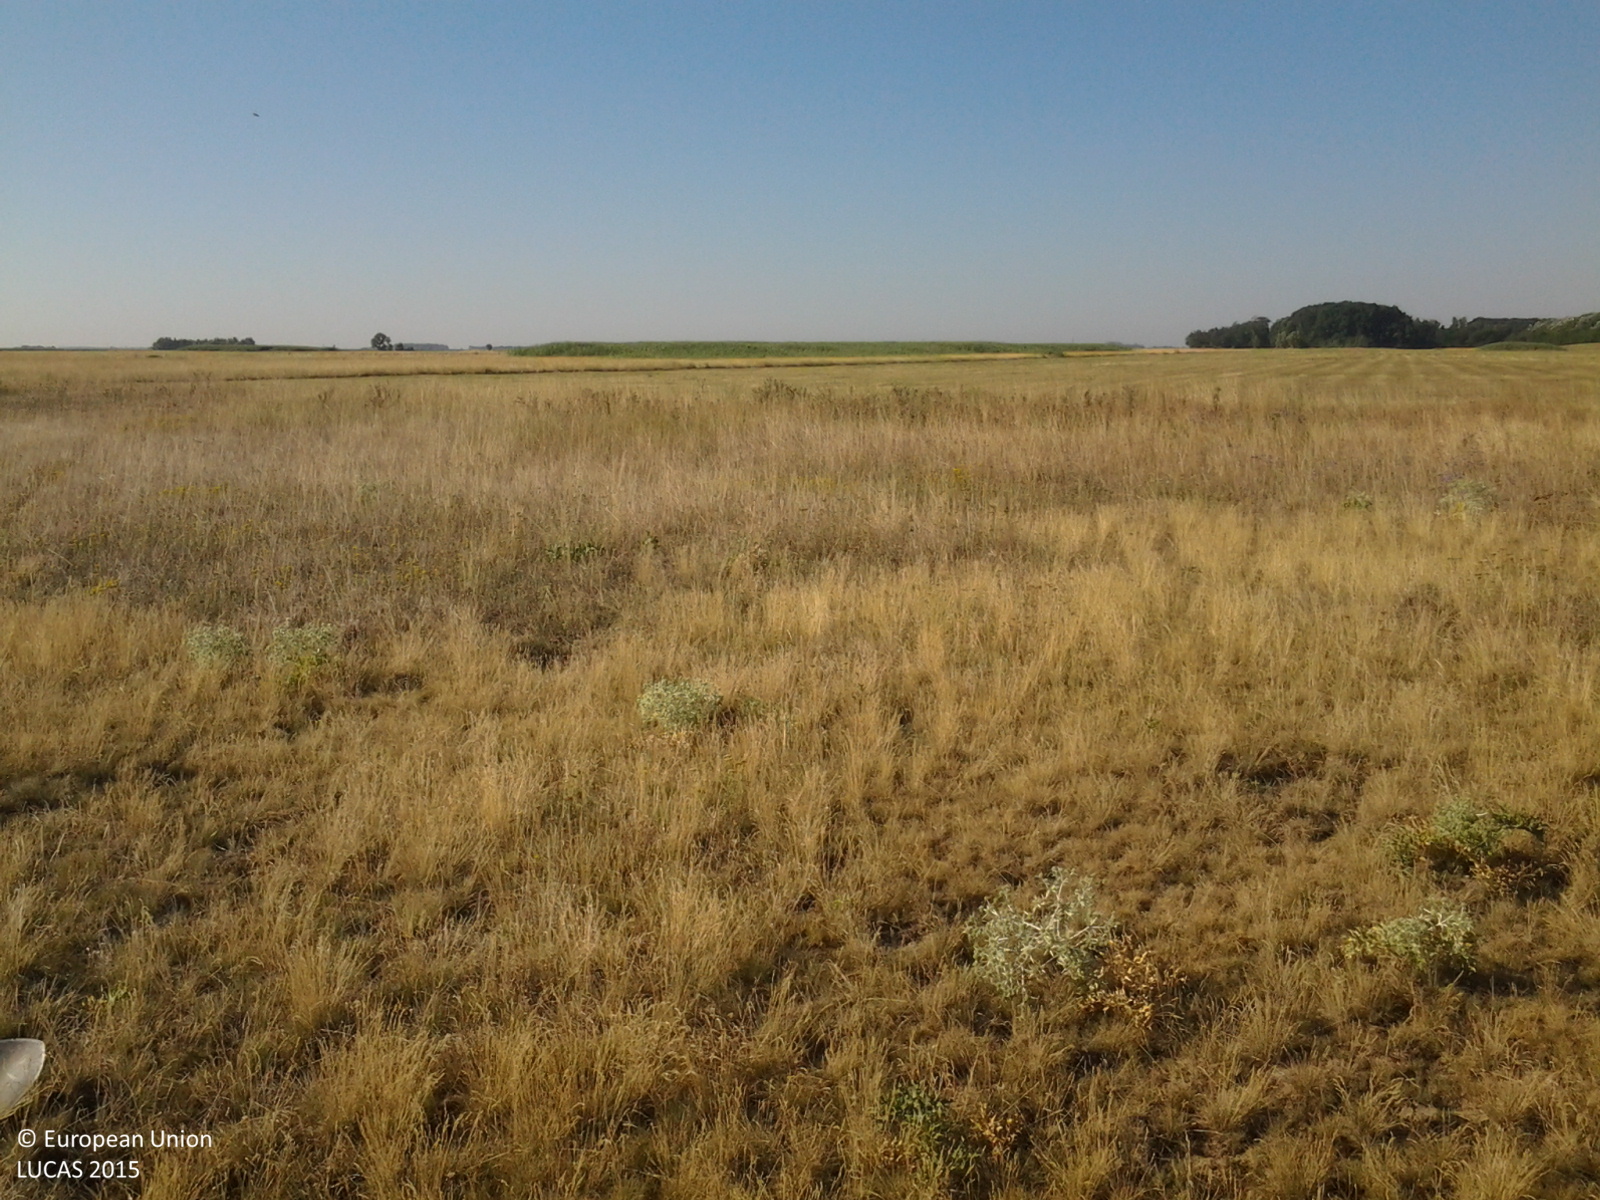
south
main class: Grassland
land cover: Grassland without tree/shrub cover
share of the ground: > 75 %
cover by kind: herbaceous plants 100 %
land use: Agriculture (excluding fallow land and kitchen gardens)
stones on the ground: < 10 %
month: July
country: HU
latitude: 47.0696
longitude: 20.8440
